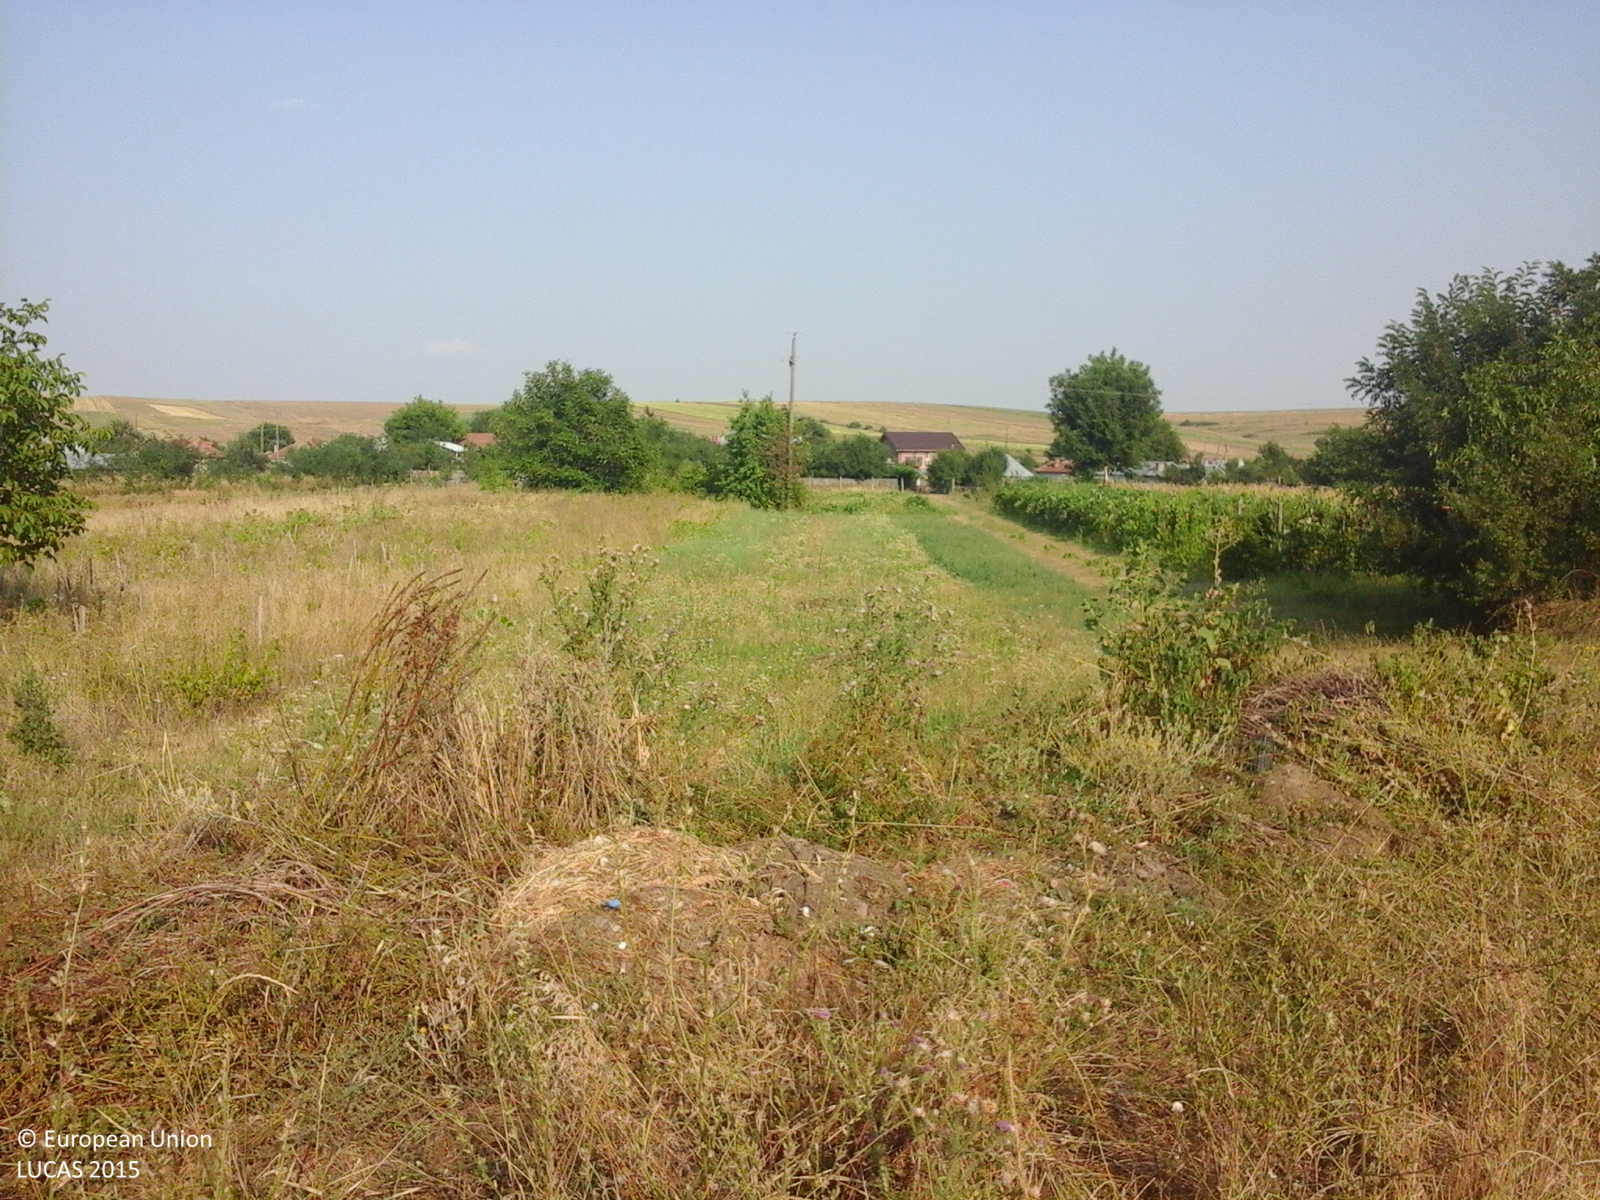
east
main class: Grassland
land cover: Grassland without tree/shrub cover
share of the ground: > 75 %
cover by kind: herbaceous plants 100 %
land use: Agriculture (excluding fallow land and kitchen gardens)
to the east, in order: Tracks; Spontaneously vegetated surfaces; Vineyards; Single bushes/trees; Artificial constructions in urban areas
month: August
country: RO
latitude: 44.4236
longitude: 23.8373
